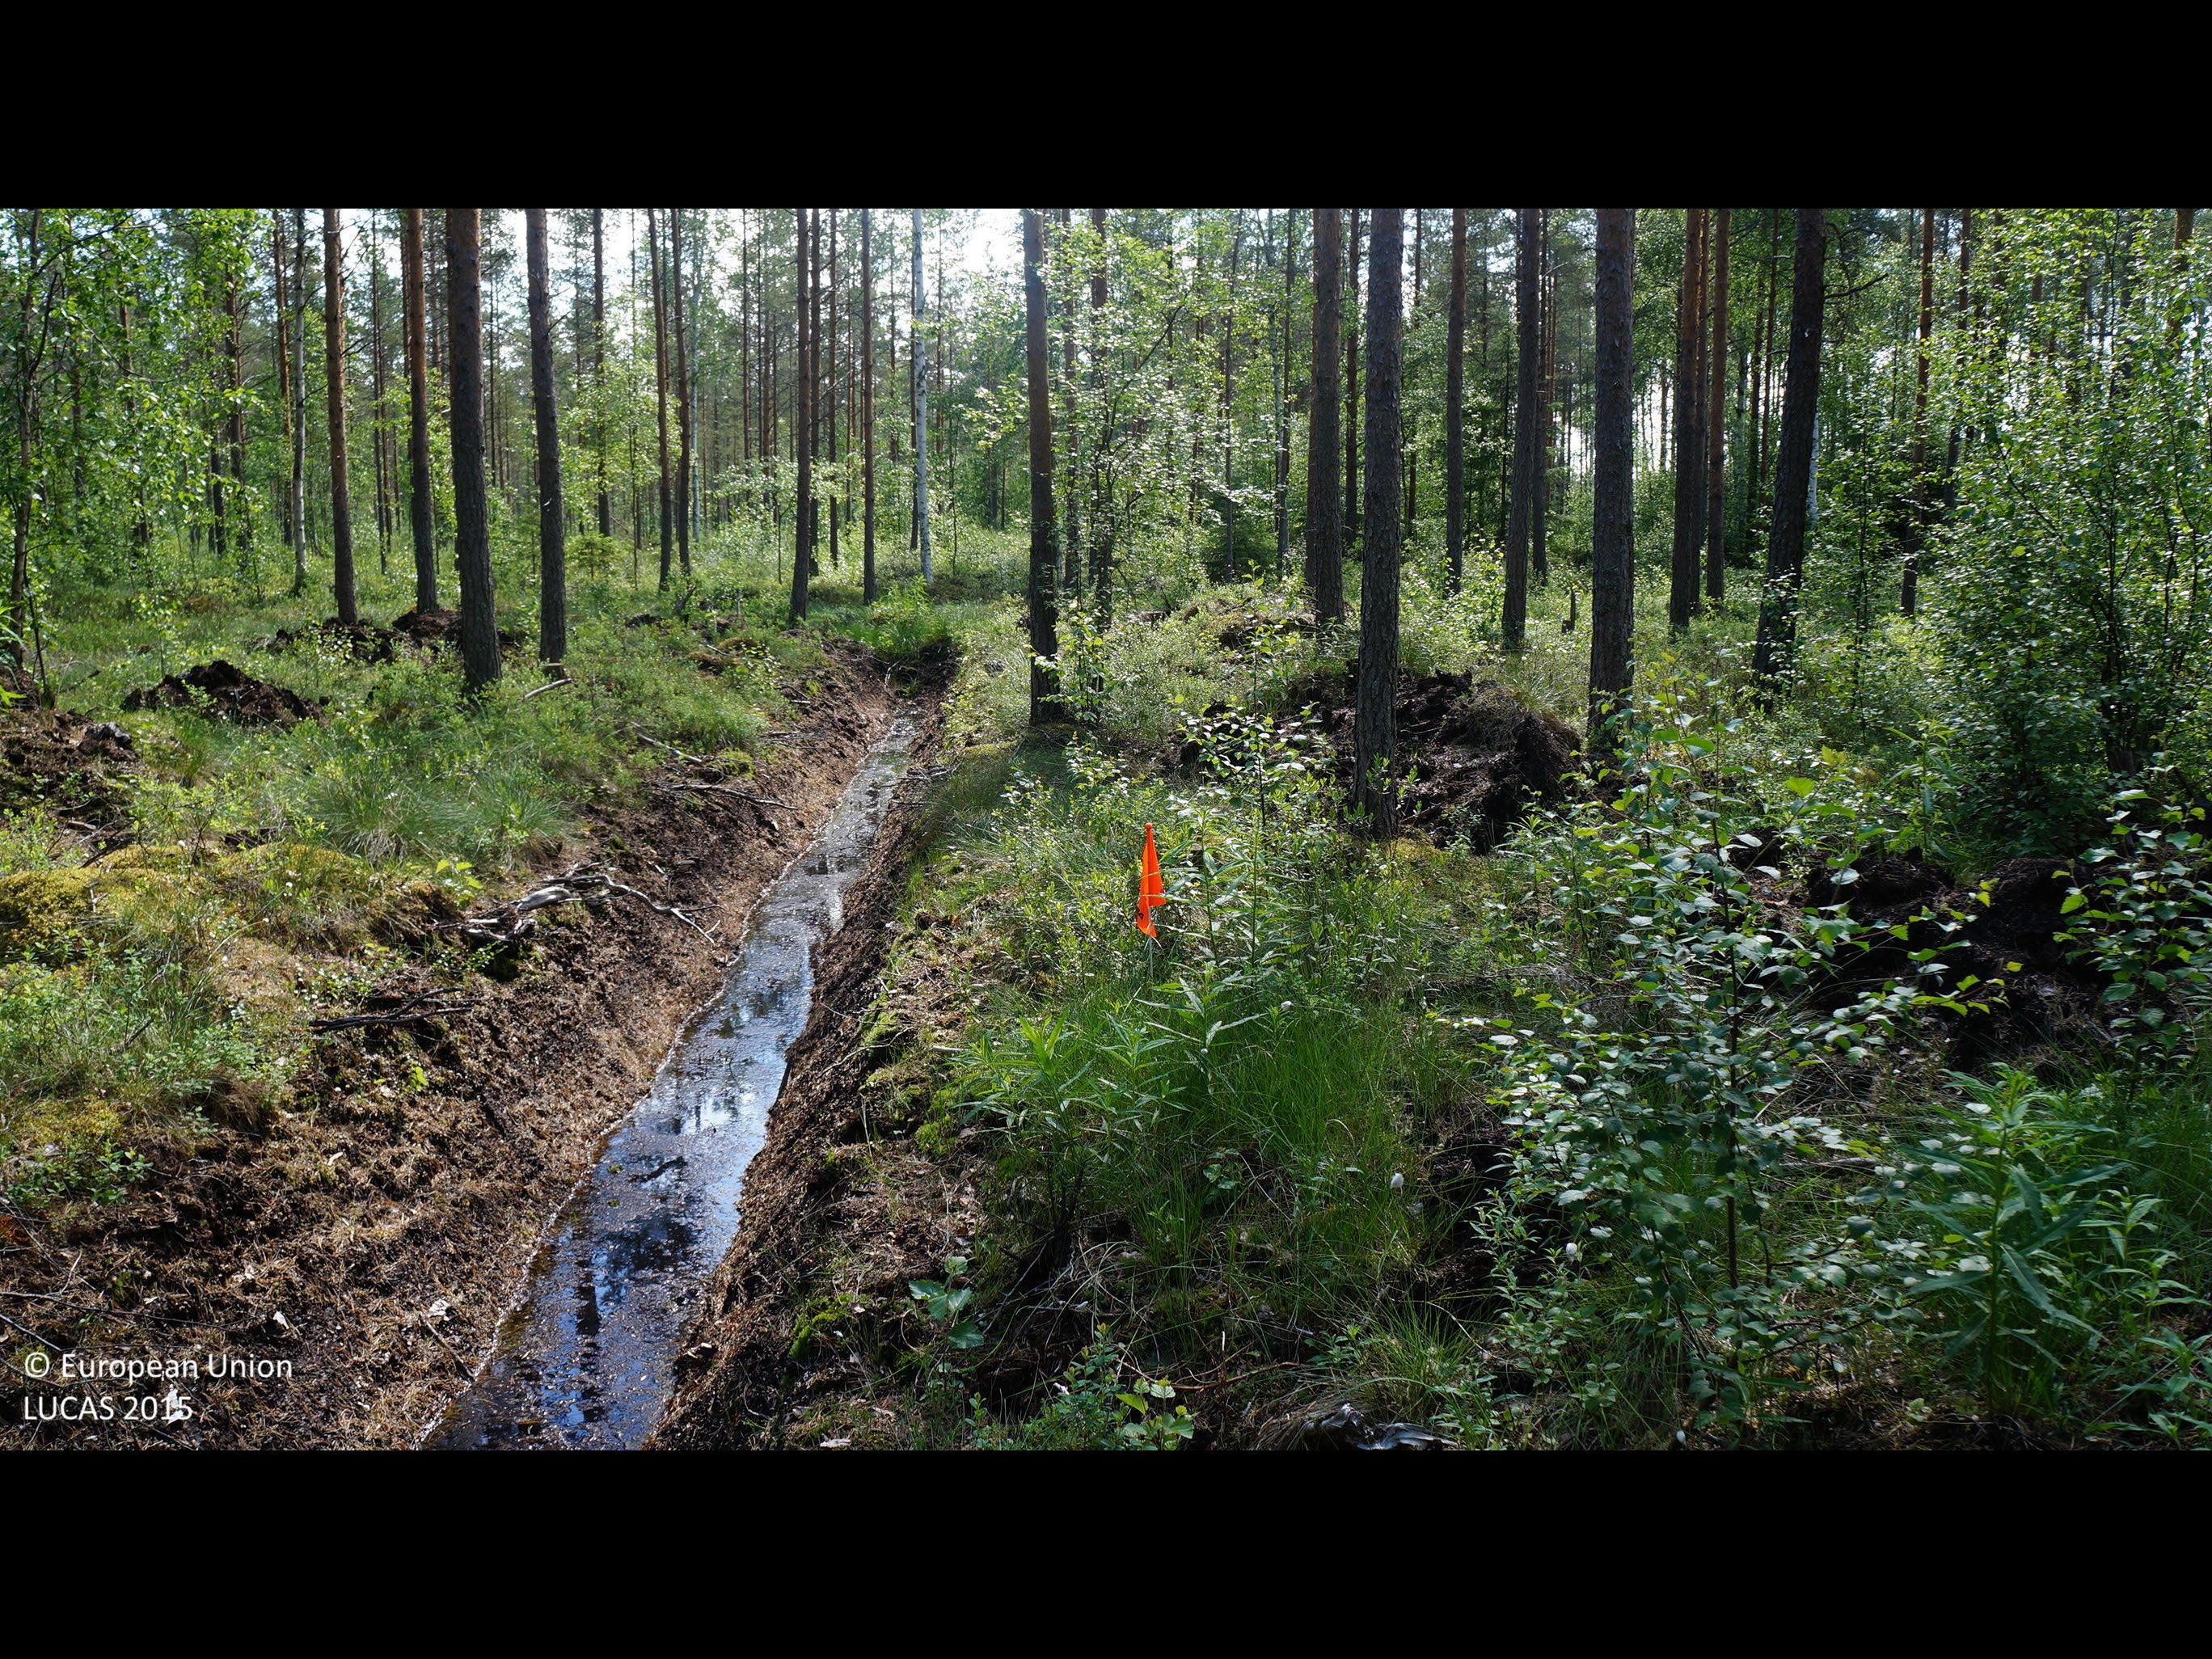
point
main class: Woodland
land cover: Pine dominated coniferous woodland
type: boreal forest
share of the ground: 50 - 75 %
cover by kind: coniferous forest trees 60 %, shrubs 20 %, broadleaved forest trees 10 %, herbaceous plants 5 %, lichens and mosses 5 %
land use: Forestry
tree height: > 5 m
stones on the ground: < 10 %
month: June
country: FI
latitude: 64.0980
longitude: 23.8705
